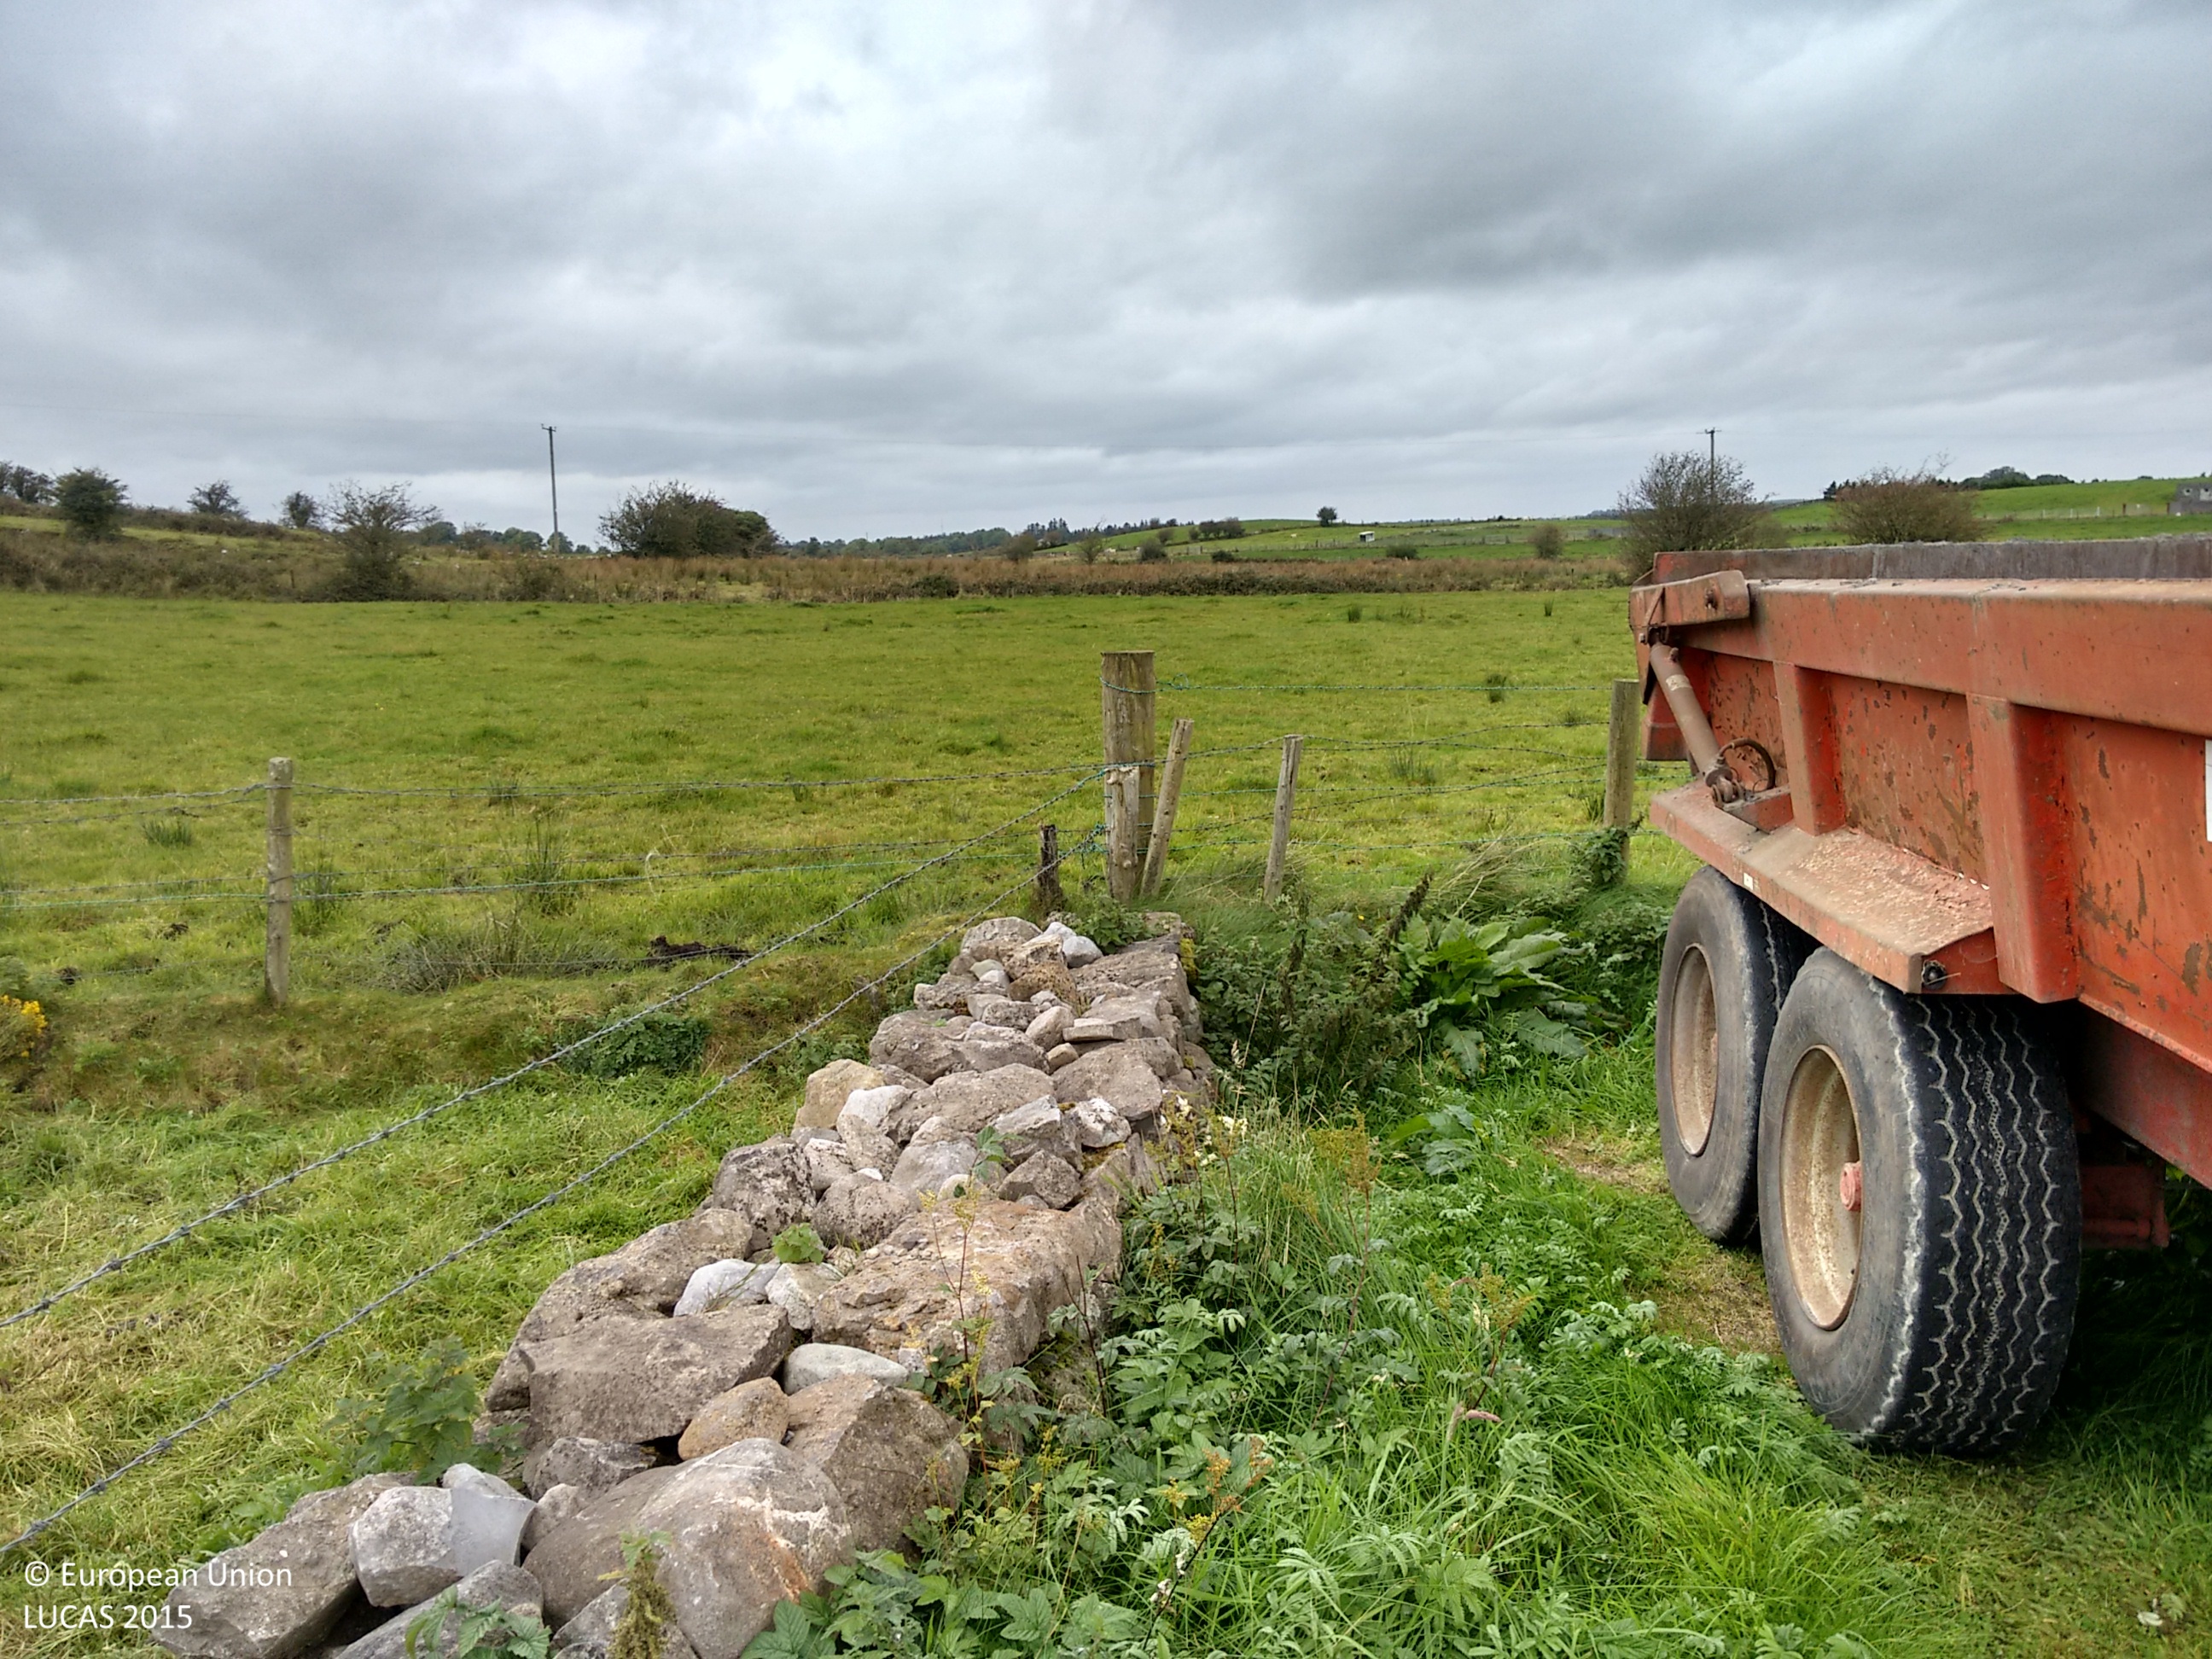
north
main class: Grassland
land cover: Grassland without tree/shrub cover
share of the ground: > 75 %
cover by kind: herbaceous plants 100 %
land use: Agriculture (excluding fallow land and kitchen gardens)
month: September
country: IE
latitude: 53.8479
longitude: -8.8253
